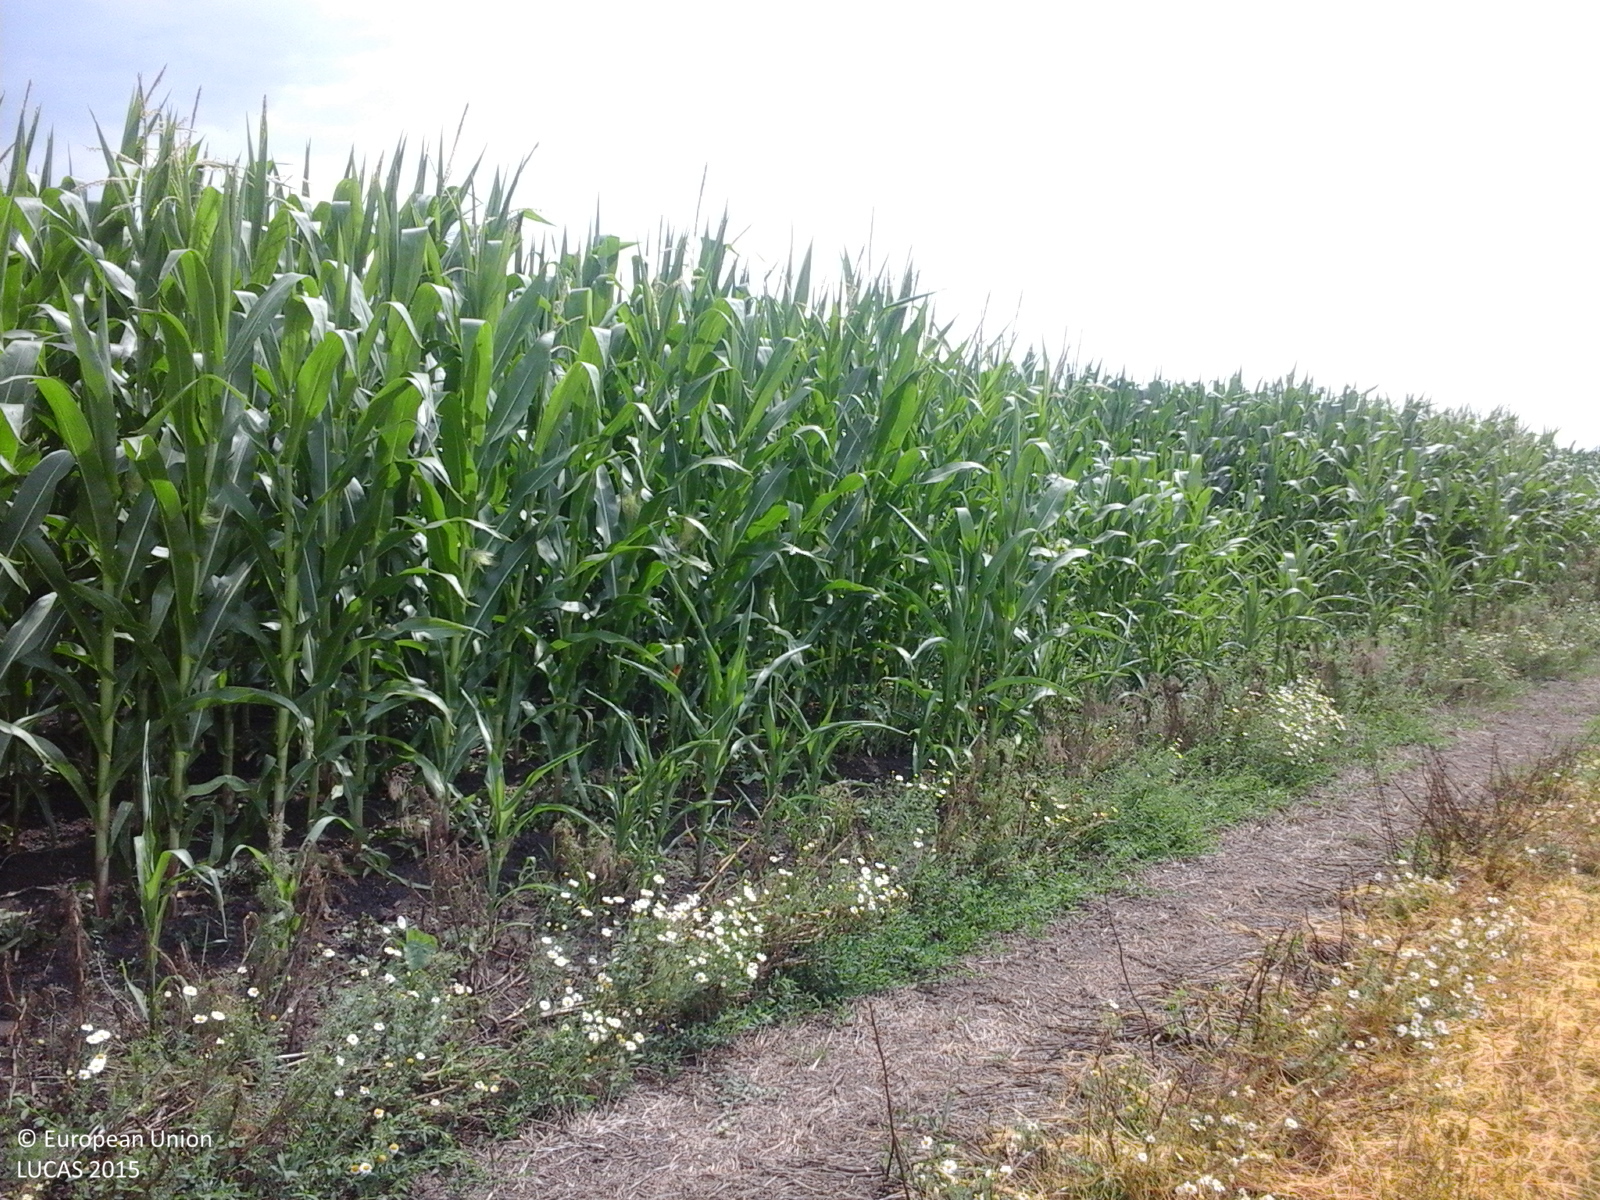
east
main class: Cropland
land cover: Maize
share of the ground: > 75 %
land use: Agriculture (excluding fallow land and kitchen gardens)
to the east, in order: Maize
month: July
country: RO
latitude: 43.8966
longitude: 25.2308
